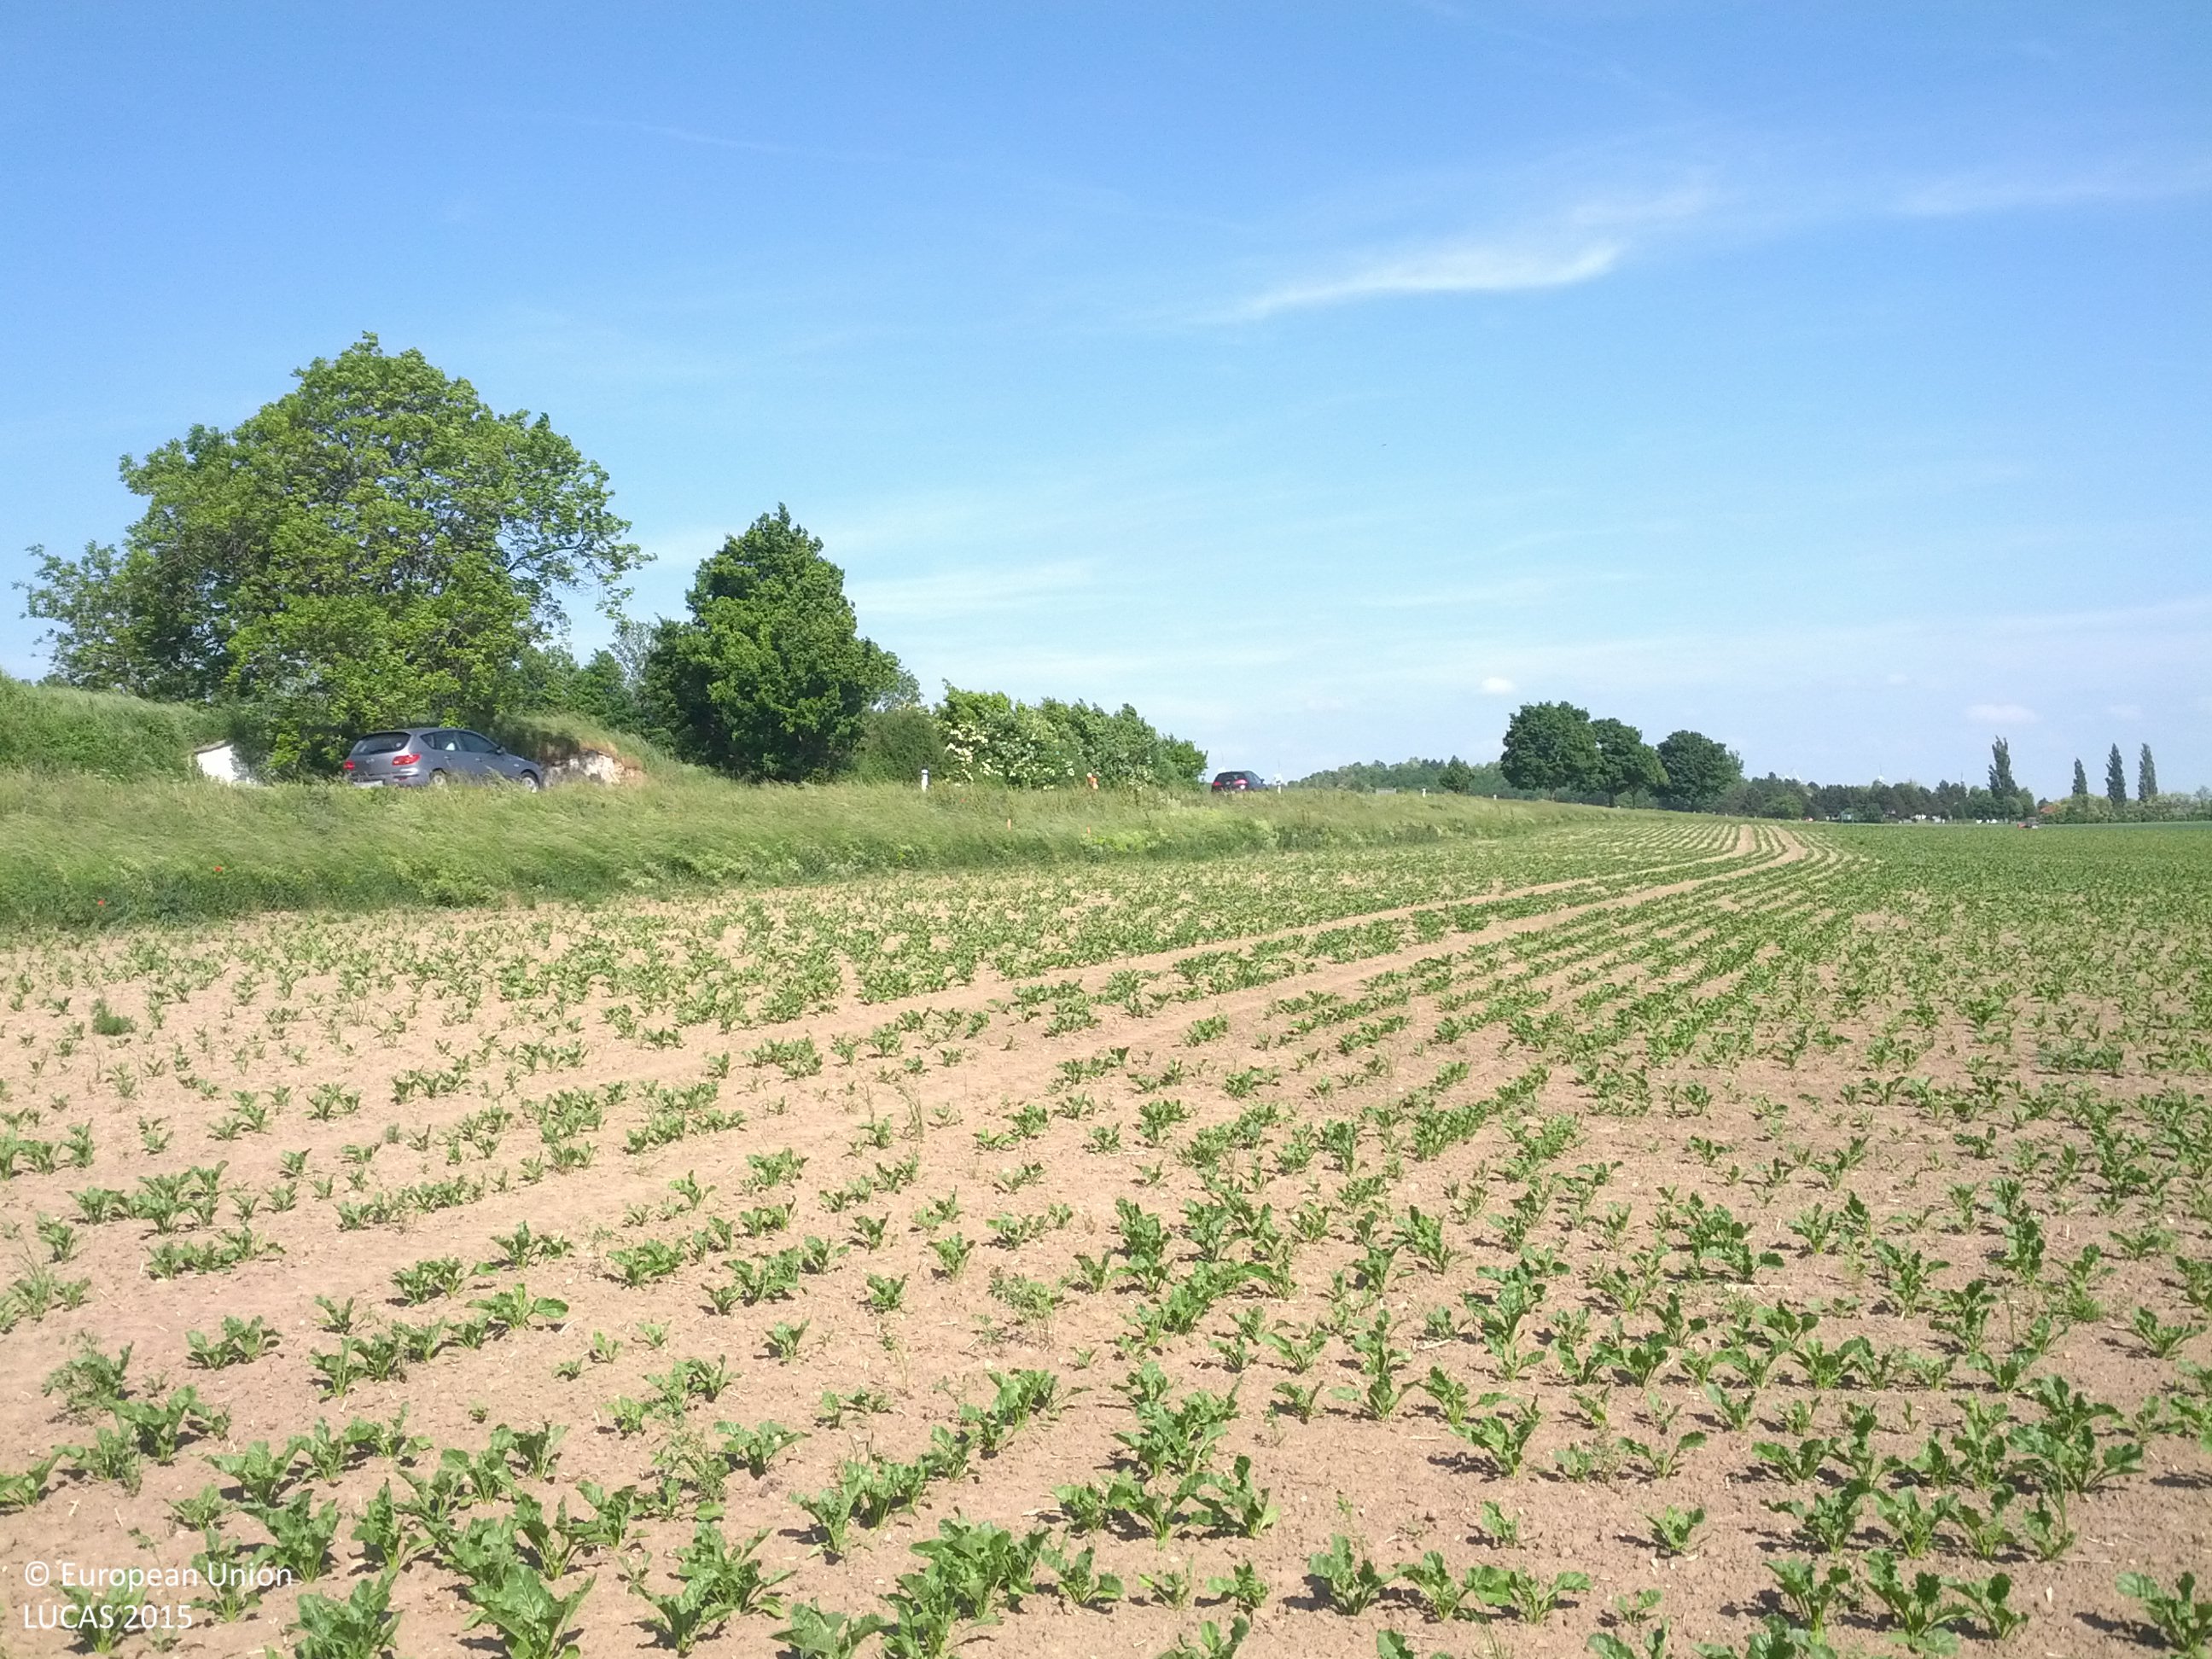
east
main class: Cropland
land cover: Sugar beet
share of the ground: < 10 %
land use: Agriculture (excluding fallow land and kitchen gardens)
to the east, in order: Sugar beet; Grassland without tree/shrub cover; Paved roads, cycling and walking lanes; Grassland without tree/shrub cover; Broadleaved woodland; Grass margins; Paved roads, cycling and walking lanes; Grass margins; Triticale
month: May
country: AT
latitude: 48.0606
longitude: 16.6208
